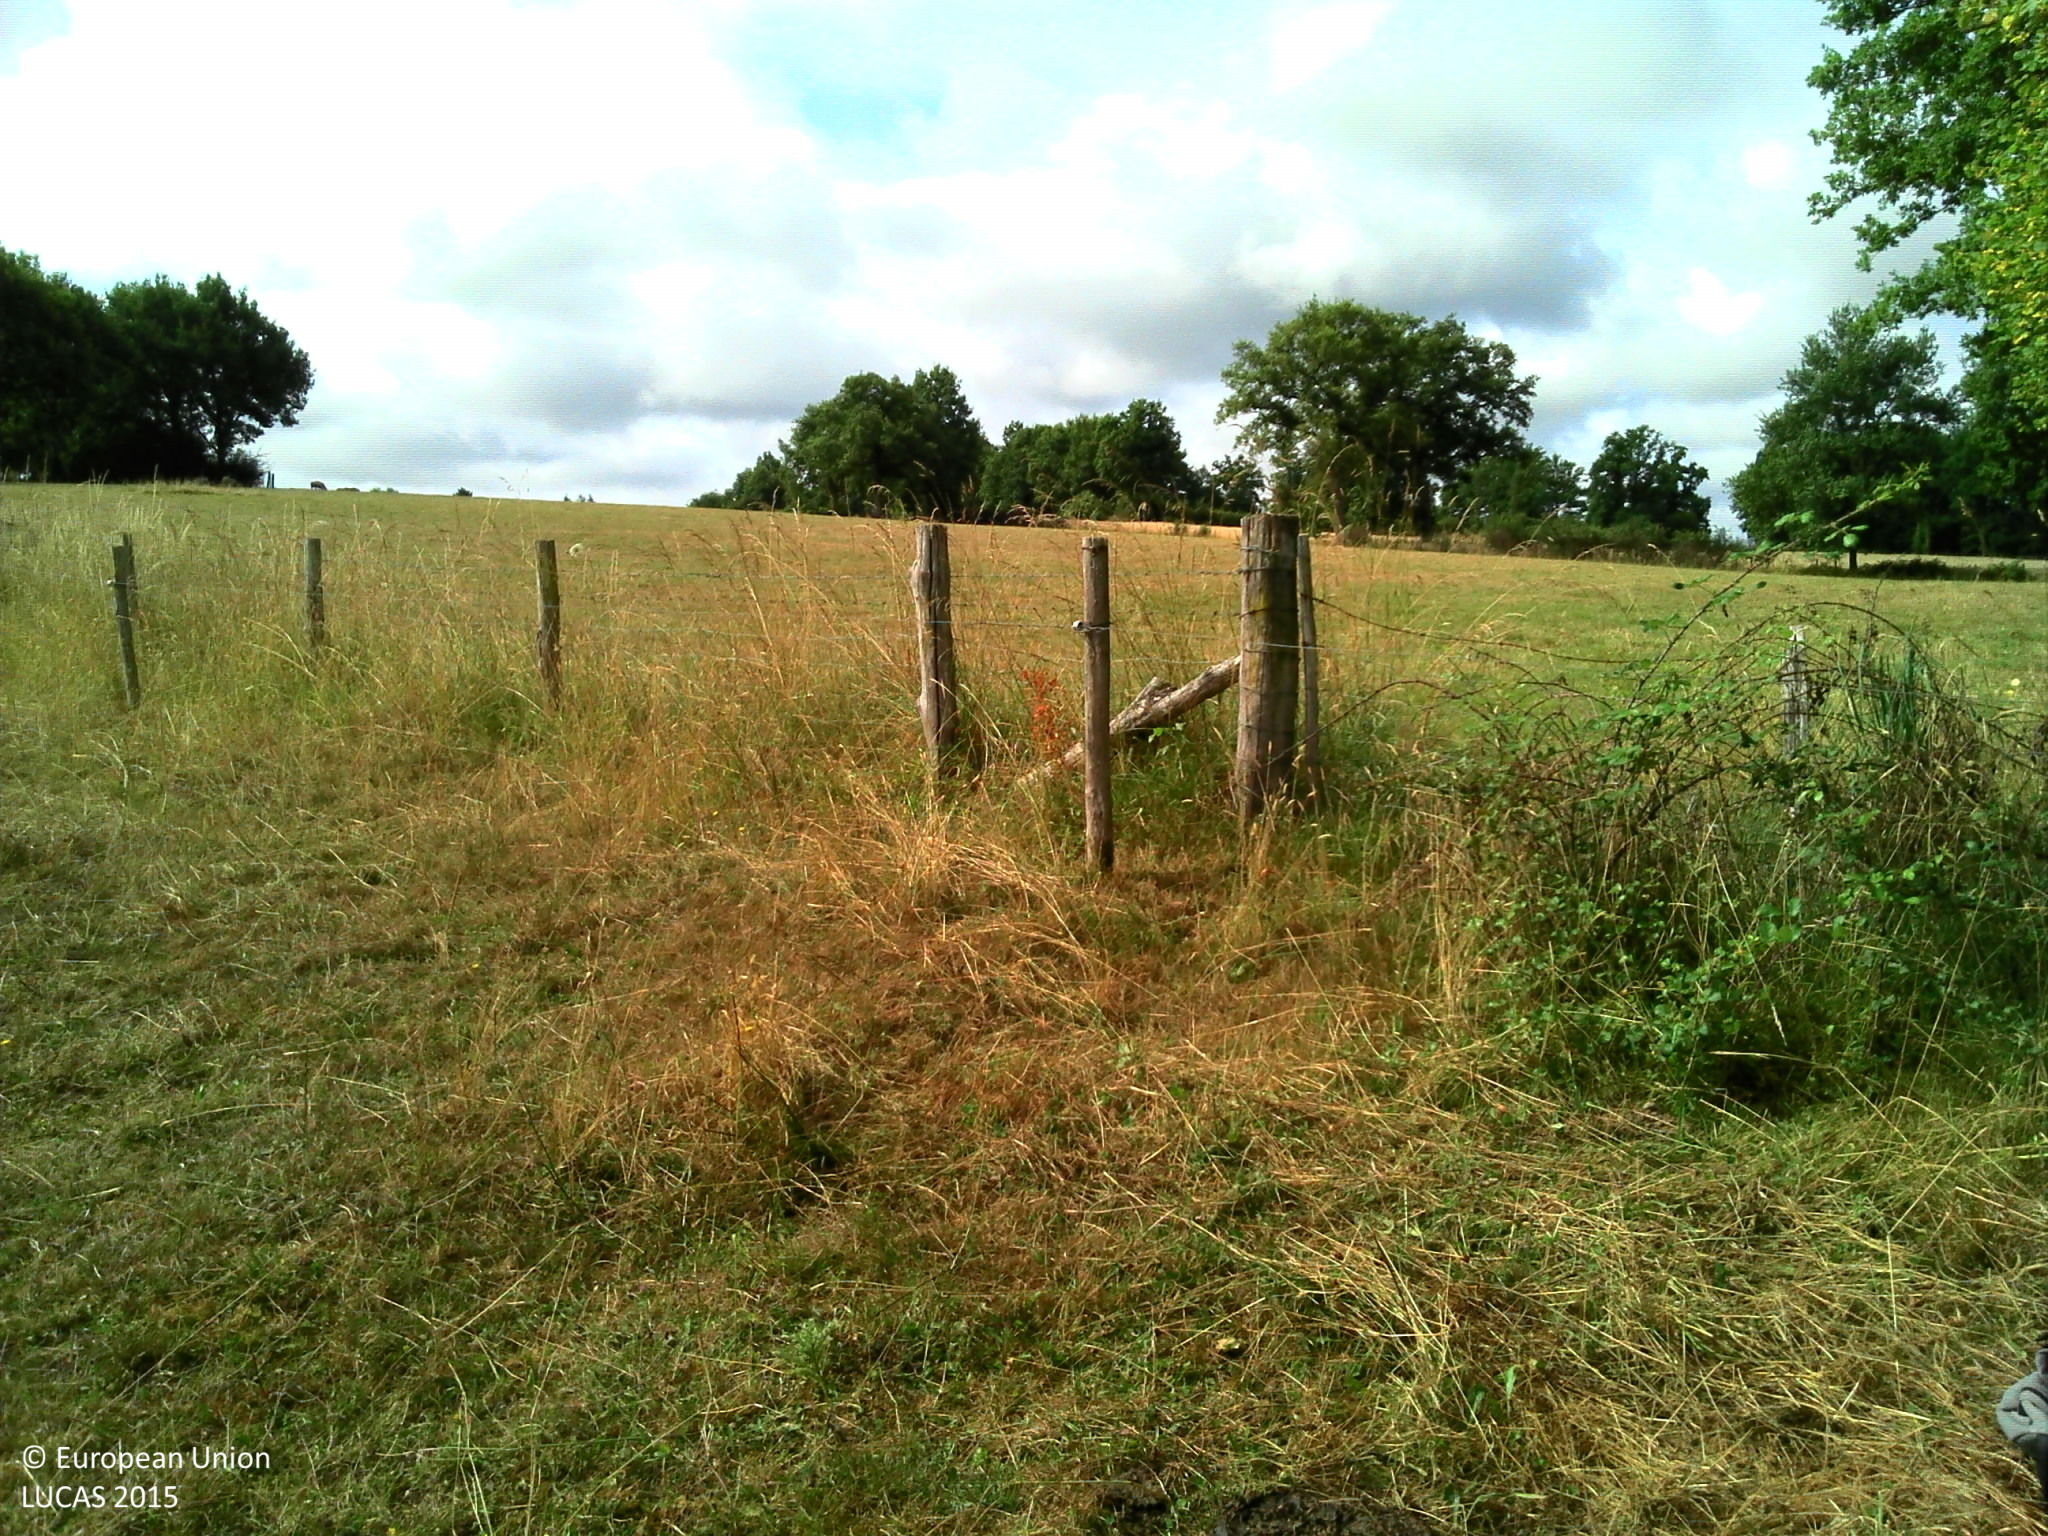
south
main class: Grassland
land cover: Grassland without tree/shrub cover
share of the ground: > 75 %
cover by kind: herbaceous plants 95 %
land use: Agriculture (excluding fallow land and kitchen gardens)
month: July
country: FR
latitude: 45.8612
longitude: 0.9856
